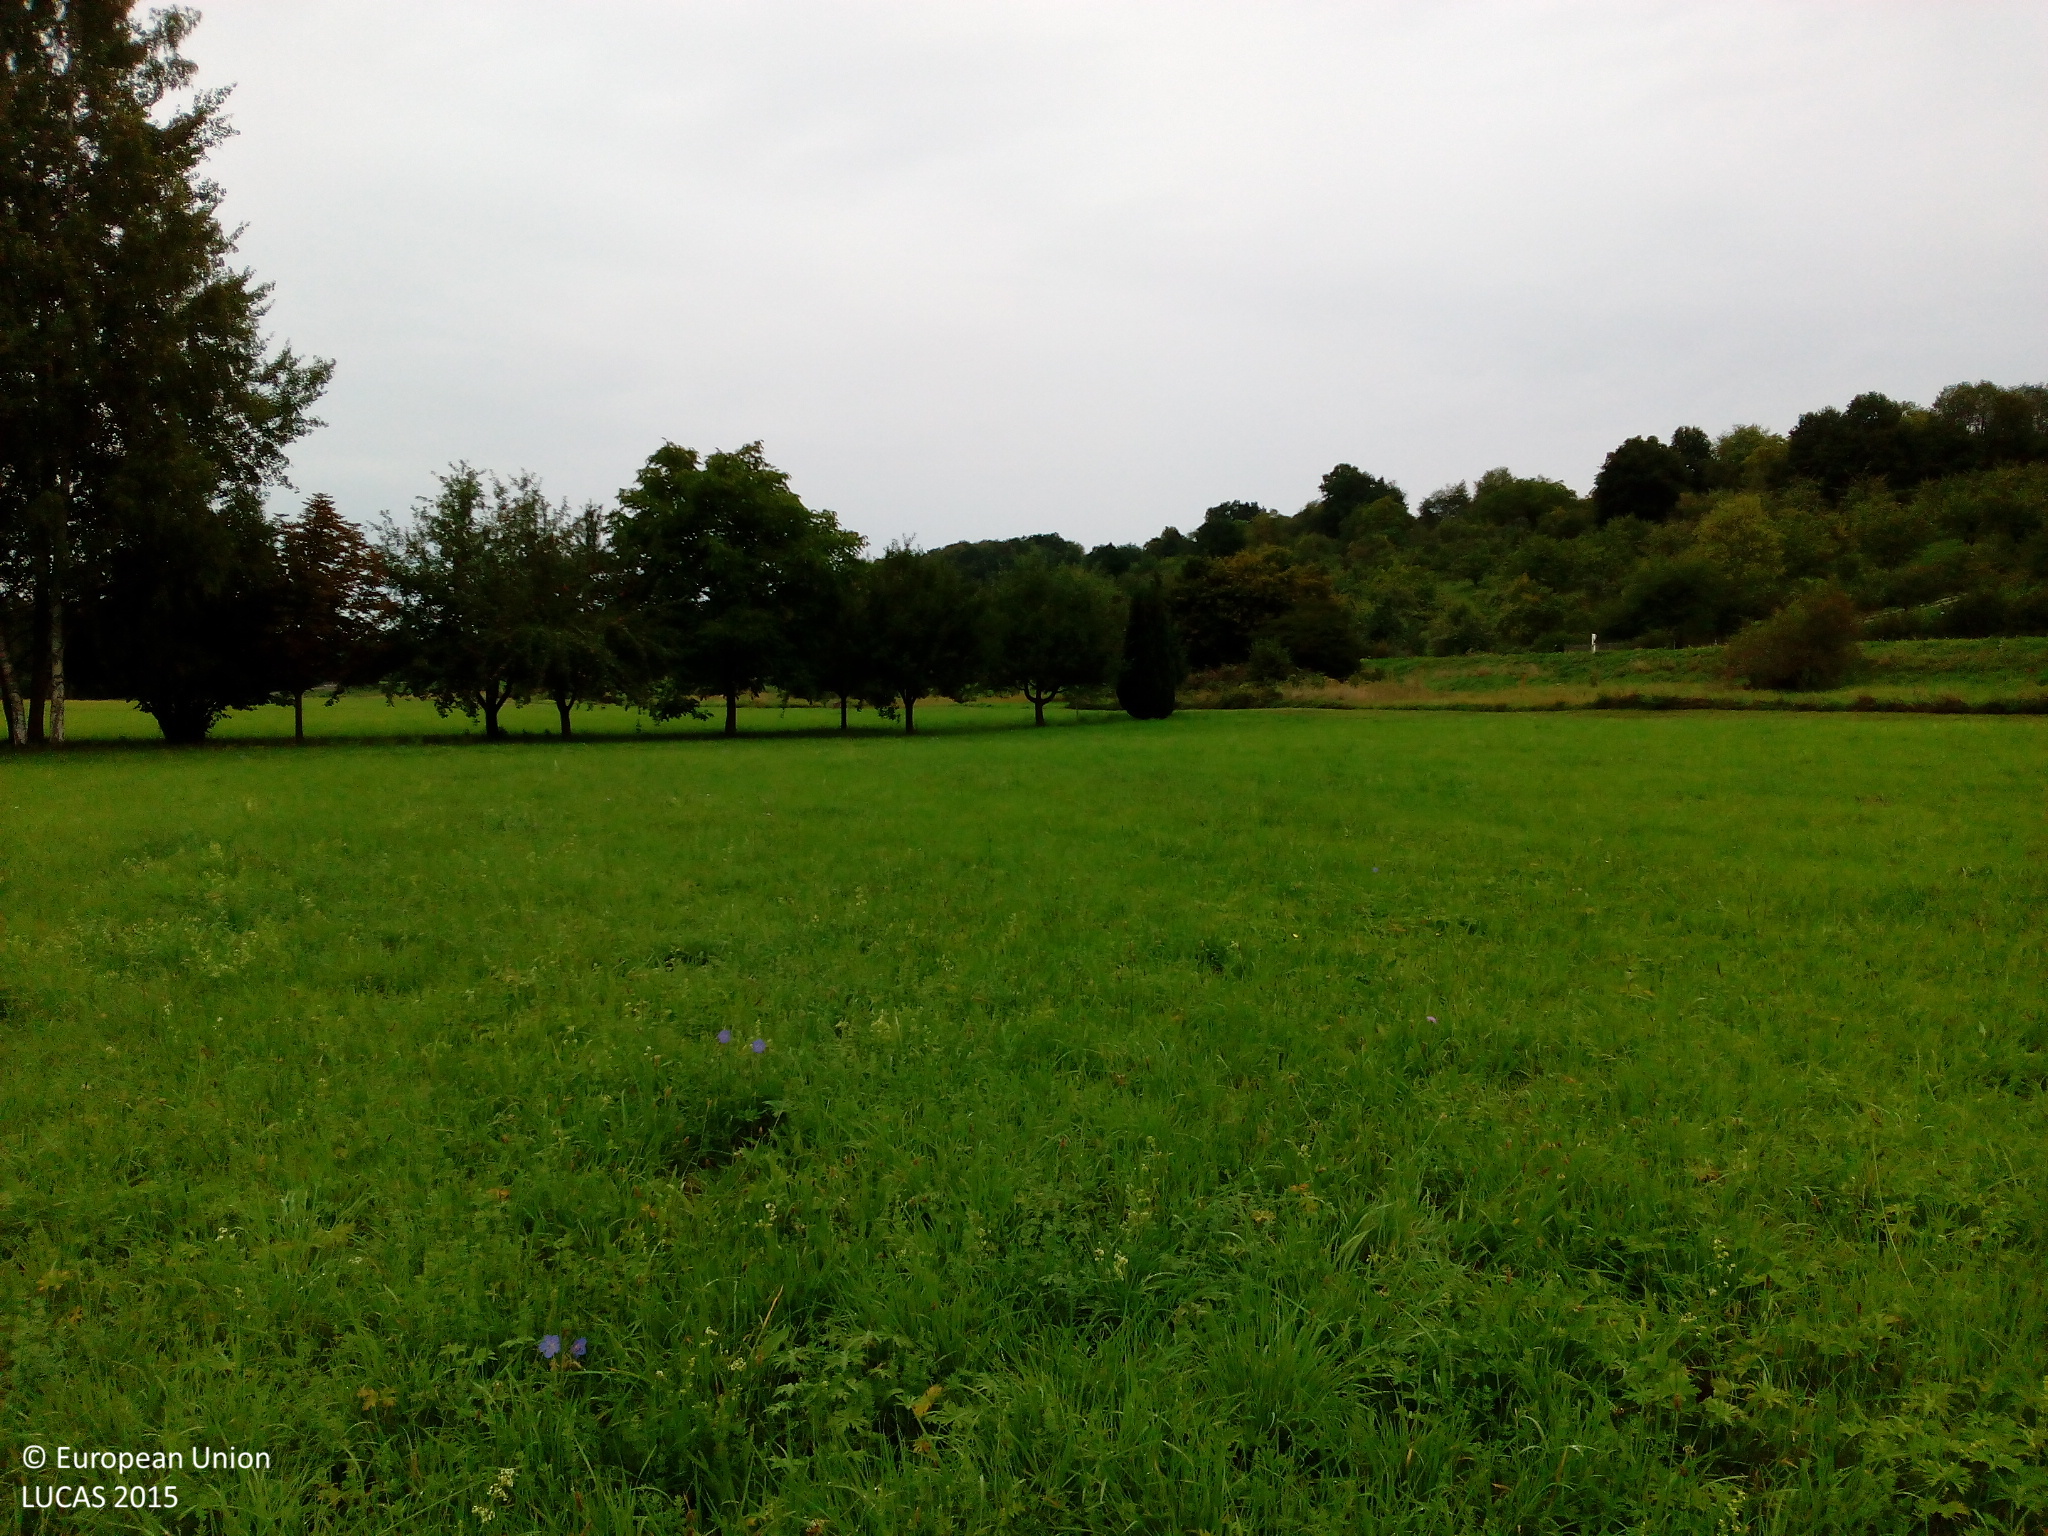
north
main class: Grassland
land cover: Grassland without tree/shrub cover
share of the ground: > 75 %
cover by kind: herbaceous plants 100 %
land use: Agriculture (excluding fallow land and kitchen gardens)
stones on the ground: < 10 %
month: September
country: DE
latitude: 49.7518
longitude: 9.5699
